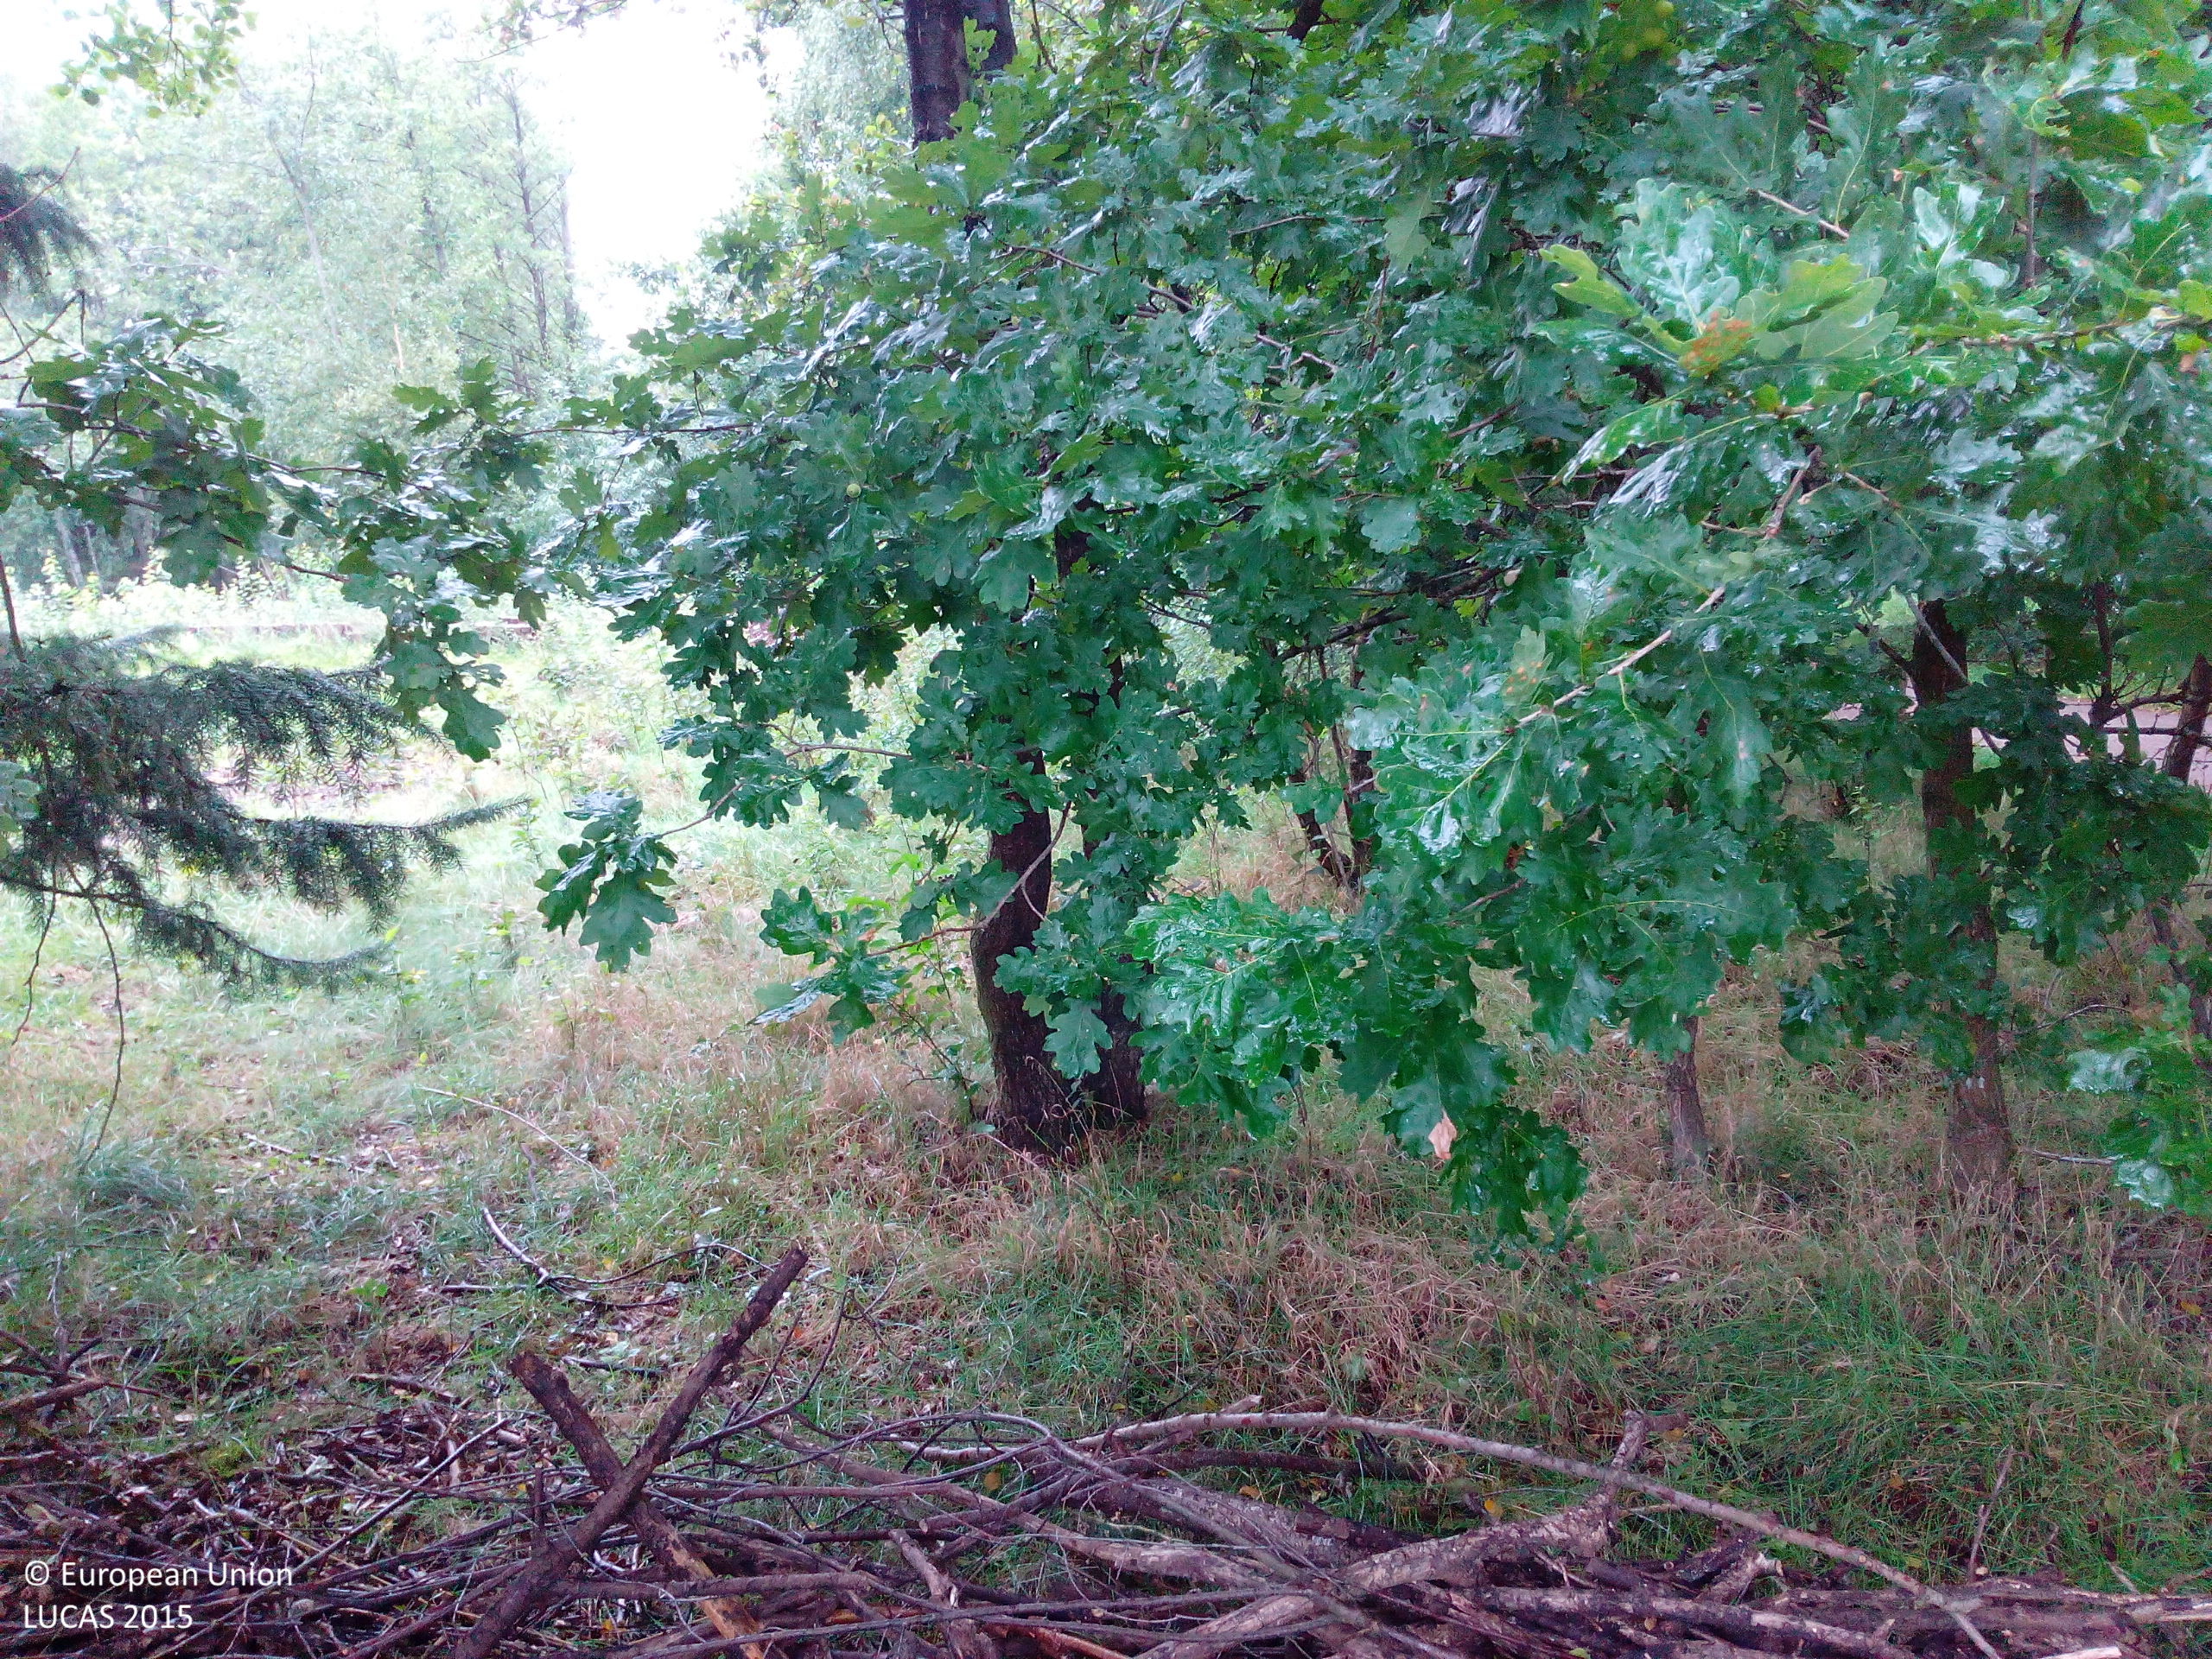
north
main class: Woodland
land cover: Broadleaved woodland
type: acidophilous oak and oak-birch forest
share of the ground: > 75 %
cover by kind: broadleaved forest trees 80 %, coniferous forest trees 10 %, herbaceous plants 10 %
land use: Agriculture (excluding fallow land and kitchen gardens)
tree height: > 5 m
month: August
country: DE
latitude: 53.7434
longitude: 9.9242
